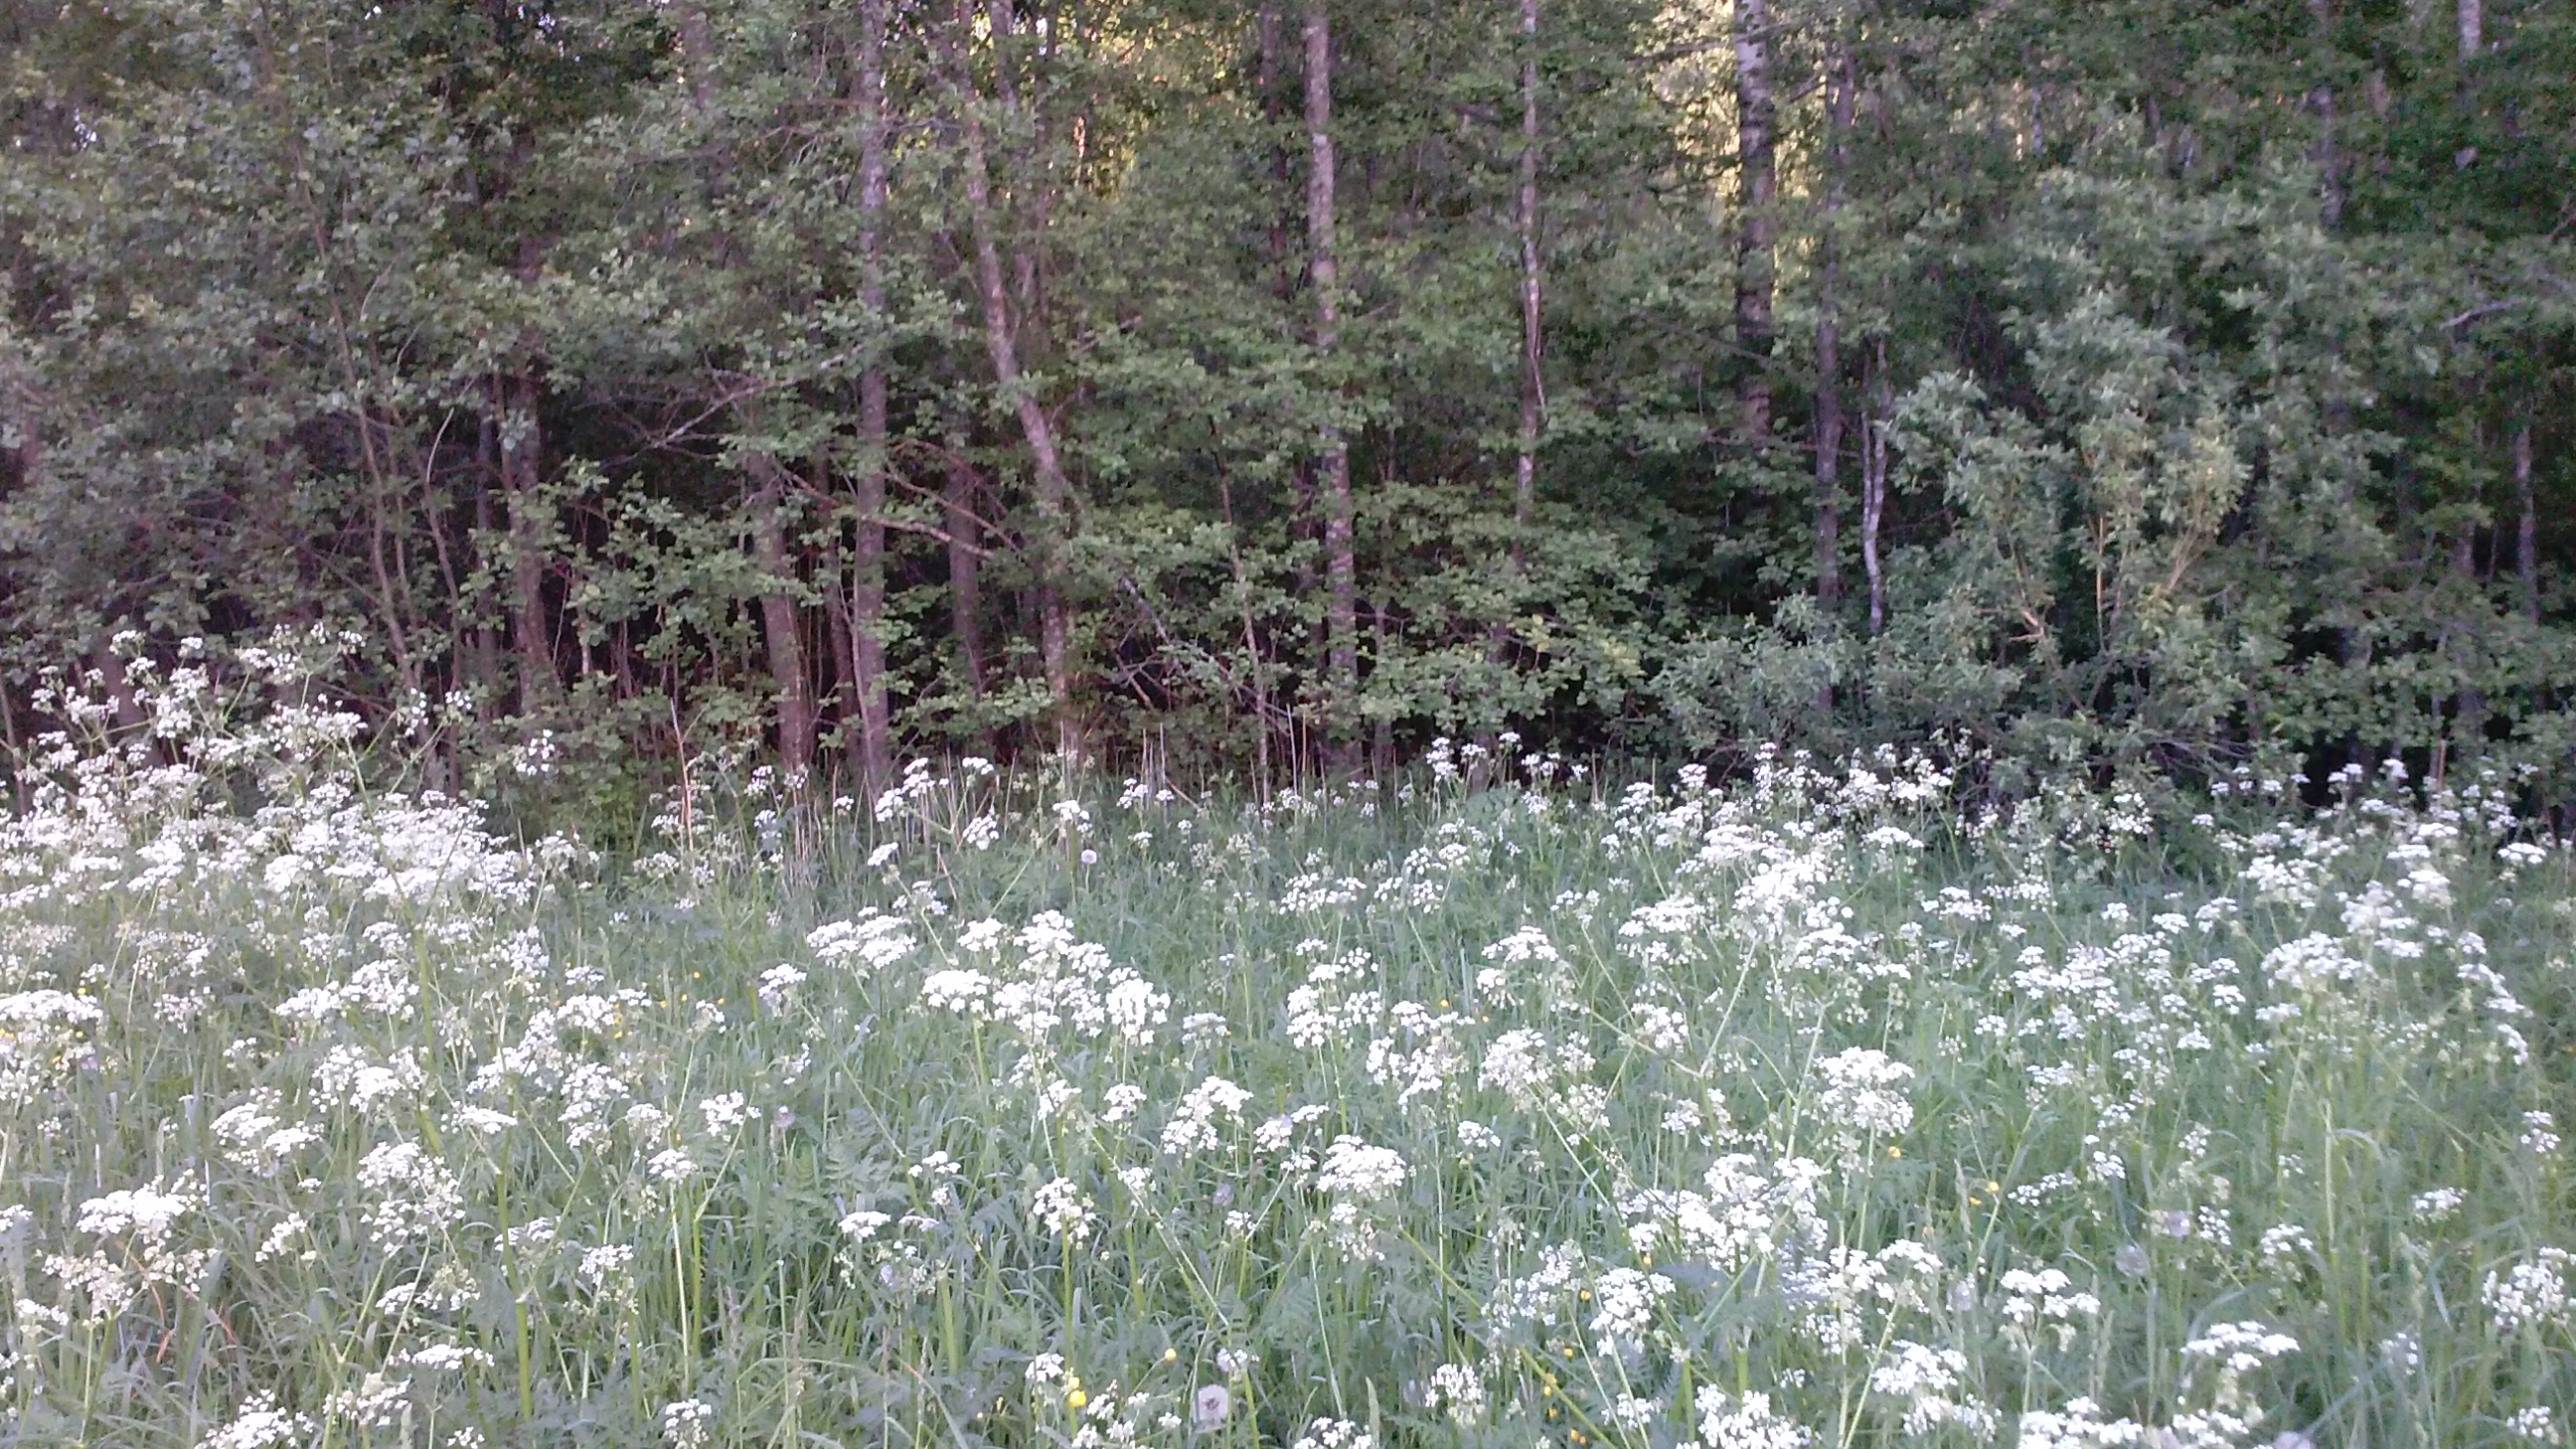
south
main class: Grassland
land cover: Spontaneously vegetated surfaces
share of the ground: > 75 %
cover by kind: herbaceous plants 100 %
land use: Fallow land
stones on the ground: < 10 %
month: June
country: LV
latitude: 56.4305
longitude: 27.8840
